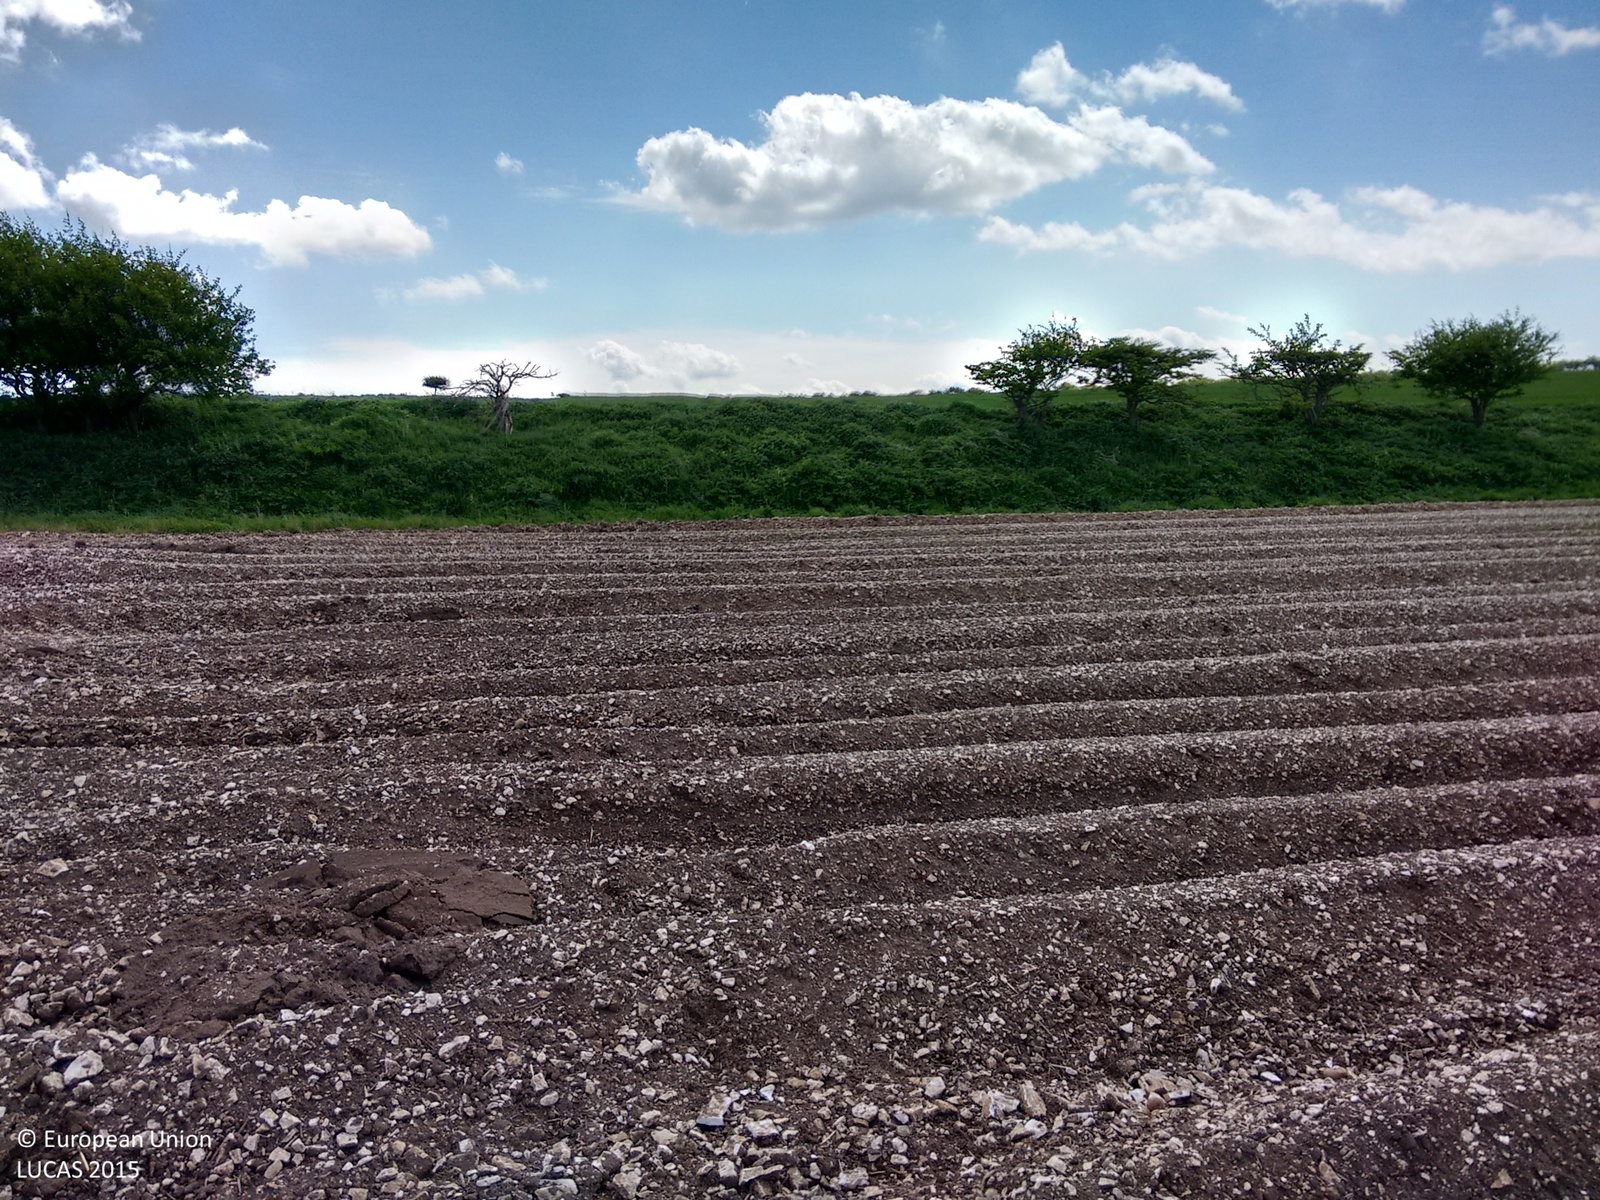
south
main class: Cropland
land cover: Potatoes
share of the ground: < 10 %
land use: Agriculture (excluding fallow land and kitchen gardens)
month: May
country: GB
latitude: 54.0863
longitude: -0.2918
